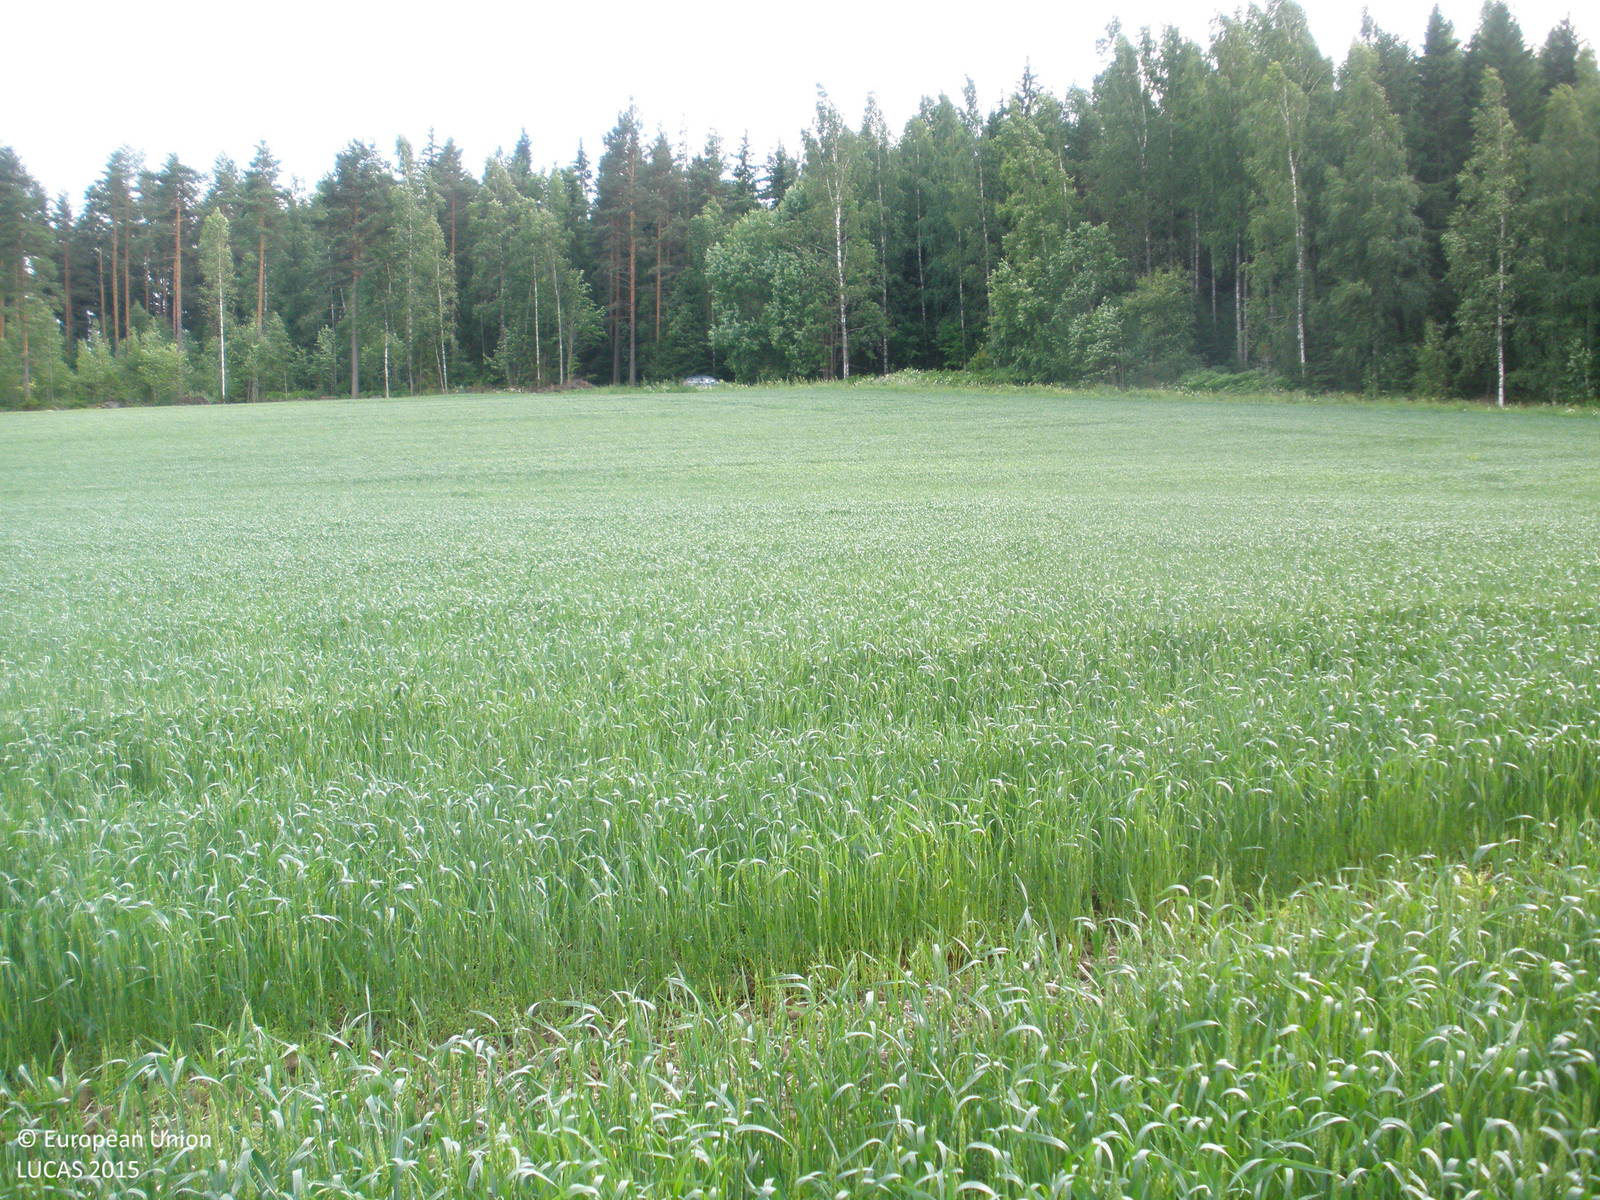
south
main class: Cropland
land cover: Common wheat
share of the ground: > 75 %
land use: Agriculture (excluding fallow land and kitchen gardens)
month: July
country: FI
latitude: 61.2723
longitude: 23.6427
